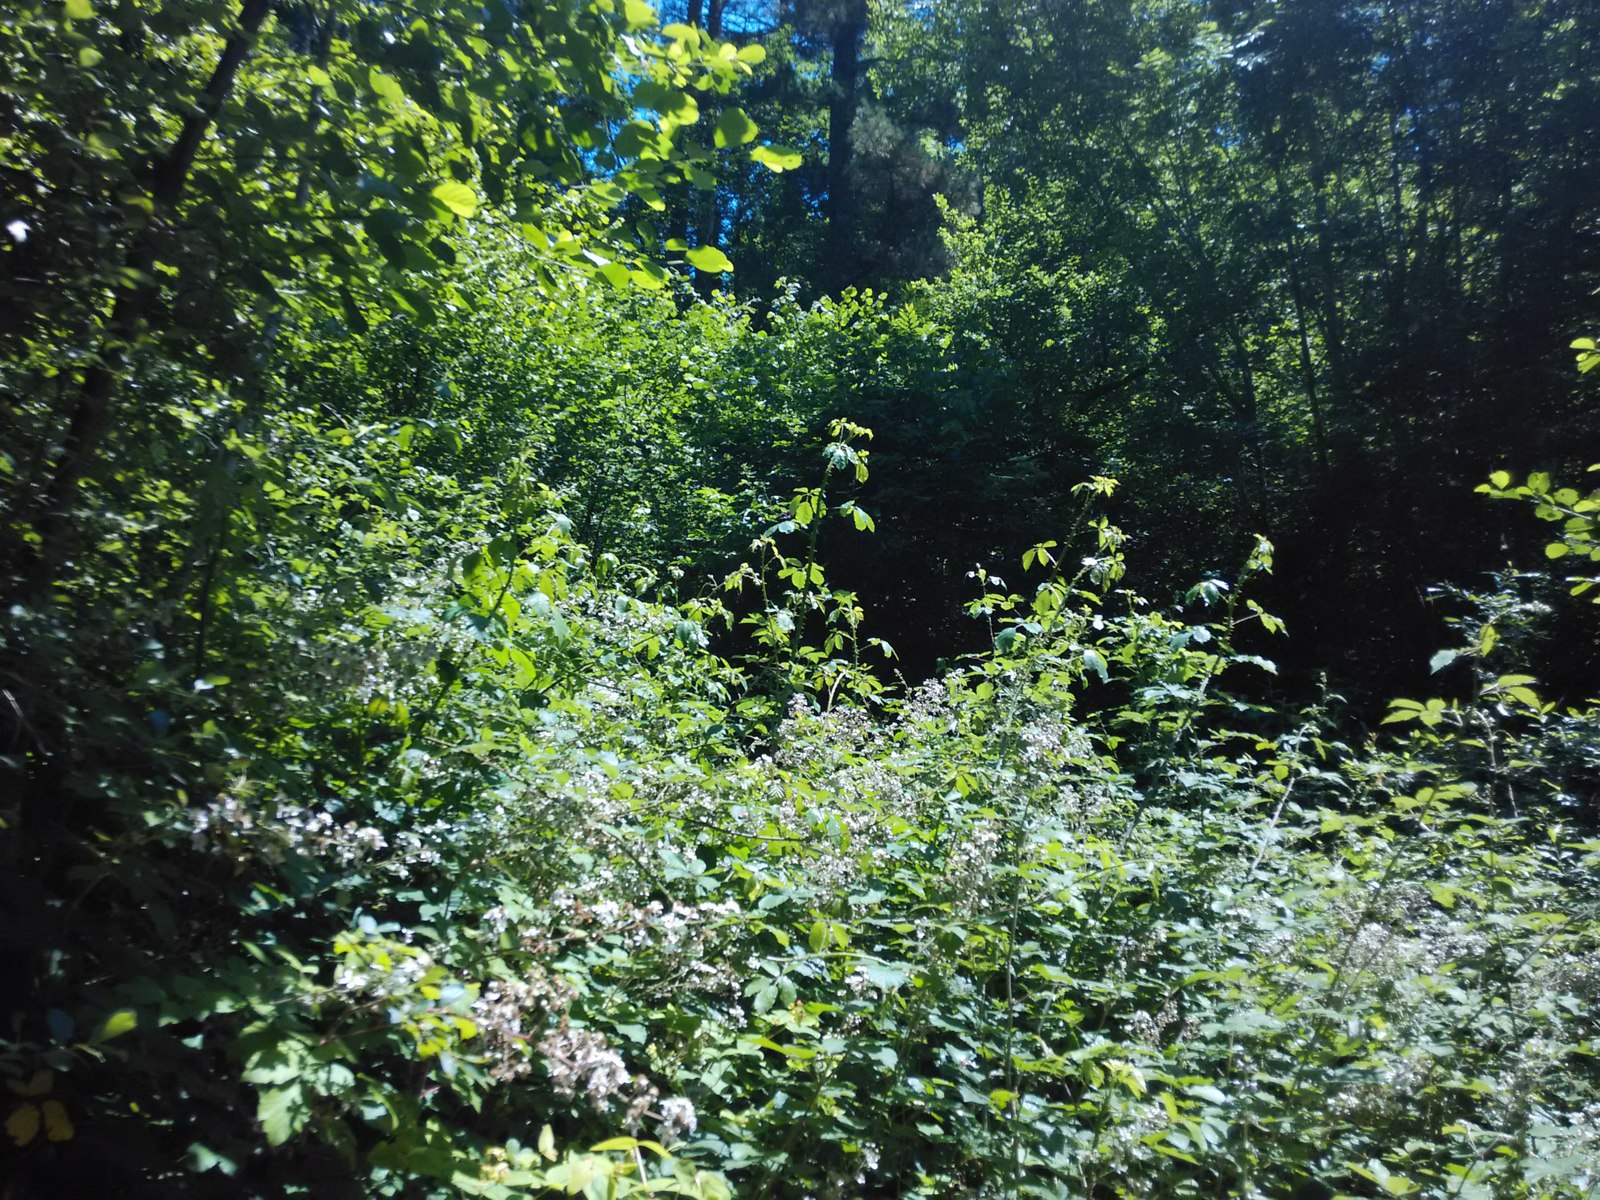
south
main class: Woodland
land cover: Other mixed woodland
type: thermophilous deciduous forest
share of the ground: > 75 %
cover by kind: broadleaved forest trees 60 %, coniferous forest trees 40 %
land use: Forestry
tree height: > 5 m
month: June
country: ES
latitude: 43.2149
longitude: -2.4478
